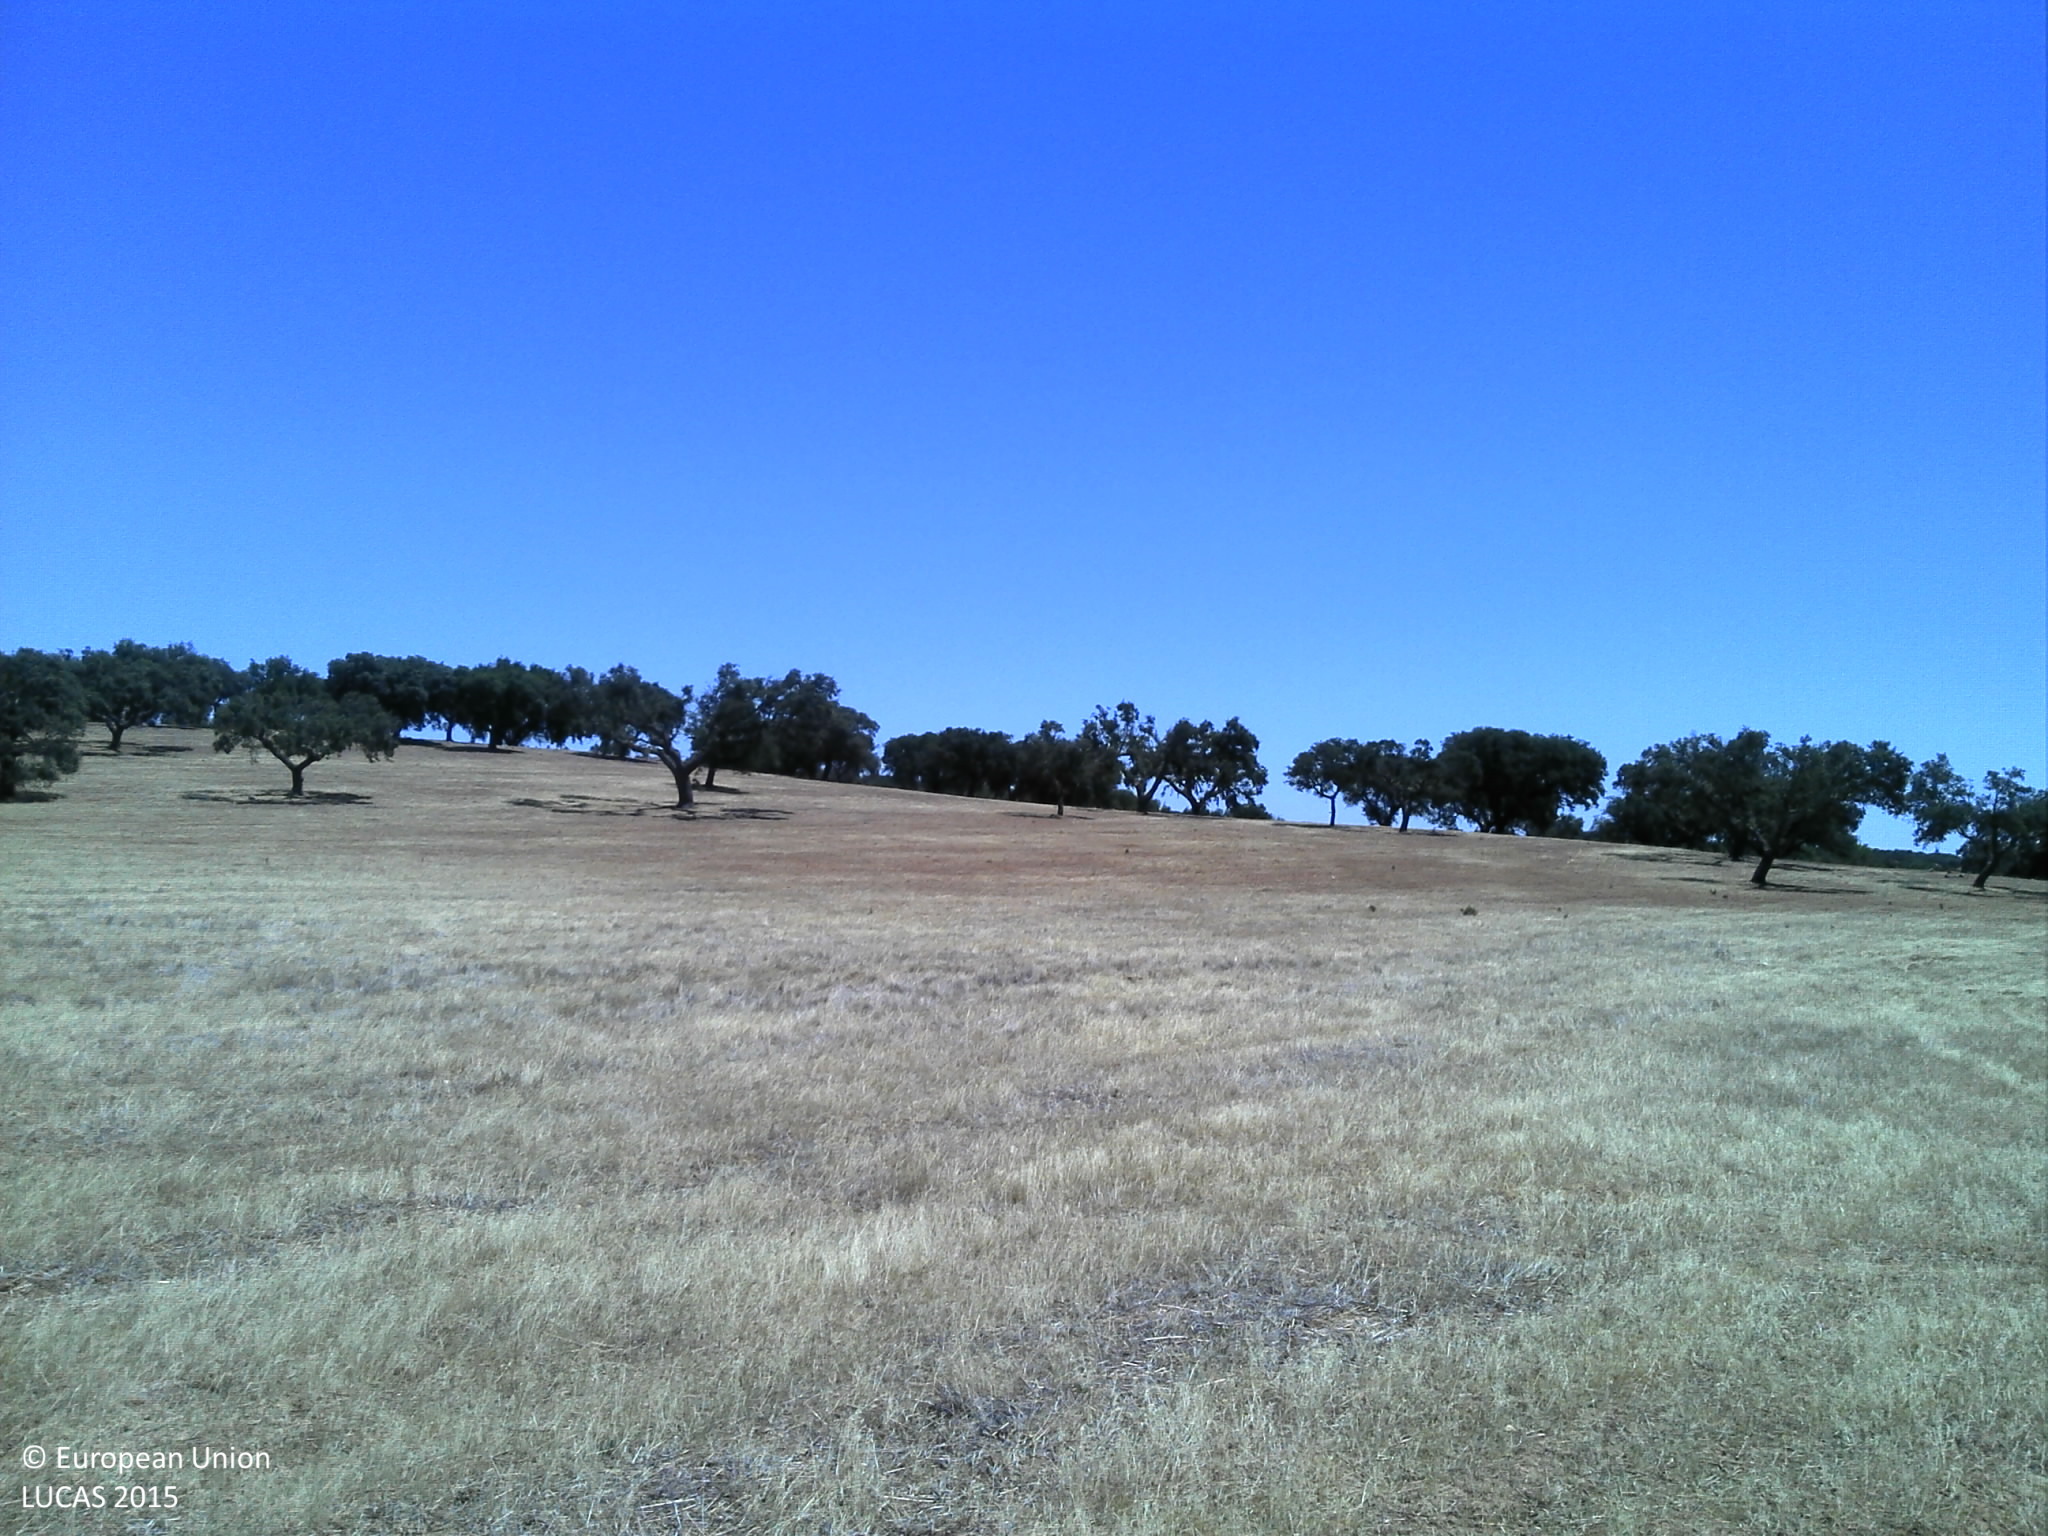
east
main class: Grassland
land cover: Grassland without tree/shrub cover
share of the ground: 10 - 25 %
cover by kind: unconsolidated bare surface 80 %, herbaceous plants 20 %
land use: Agriculture (excluding fallow land and kitchen gardens)
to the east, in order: Grassland without tree/shrub cover; Broadleaved woodland; Grassland without tree/shrub cover
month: July
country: PT
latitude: 38.8836
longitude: -7.5003
